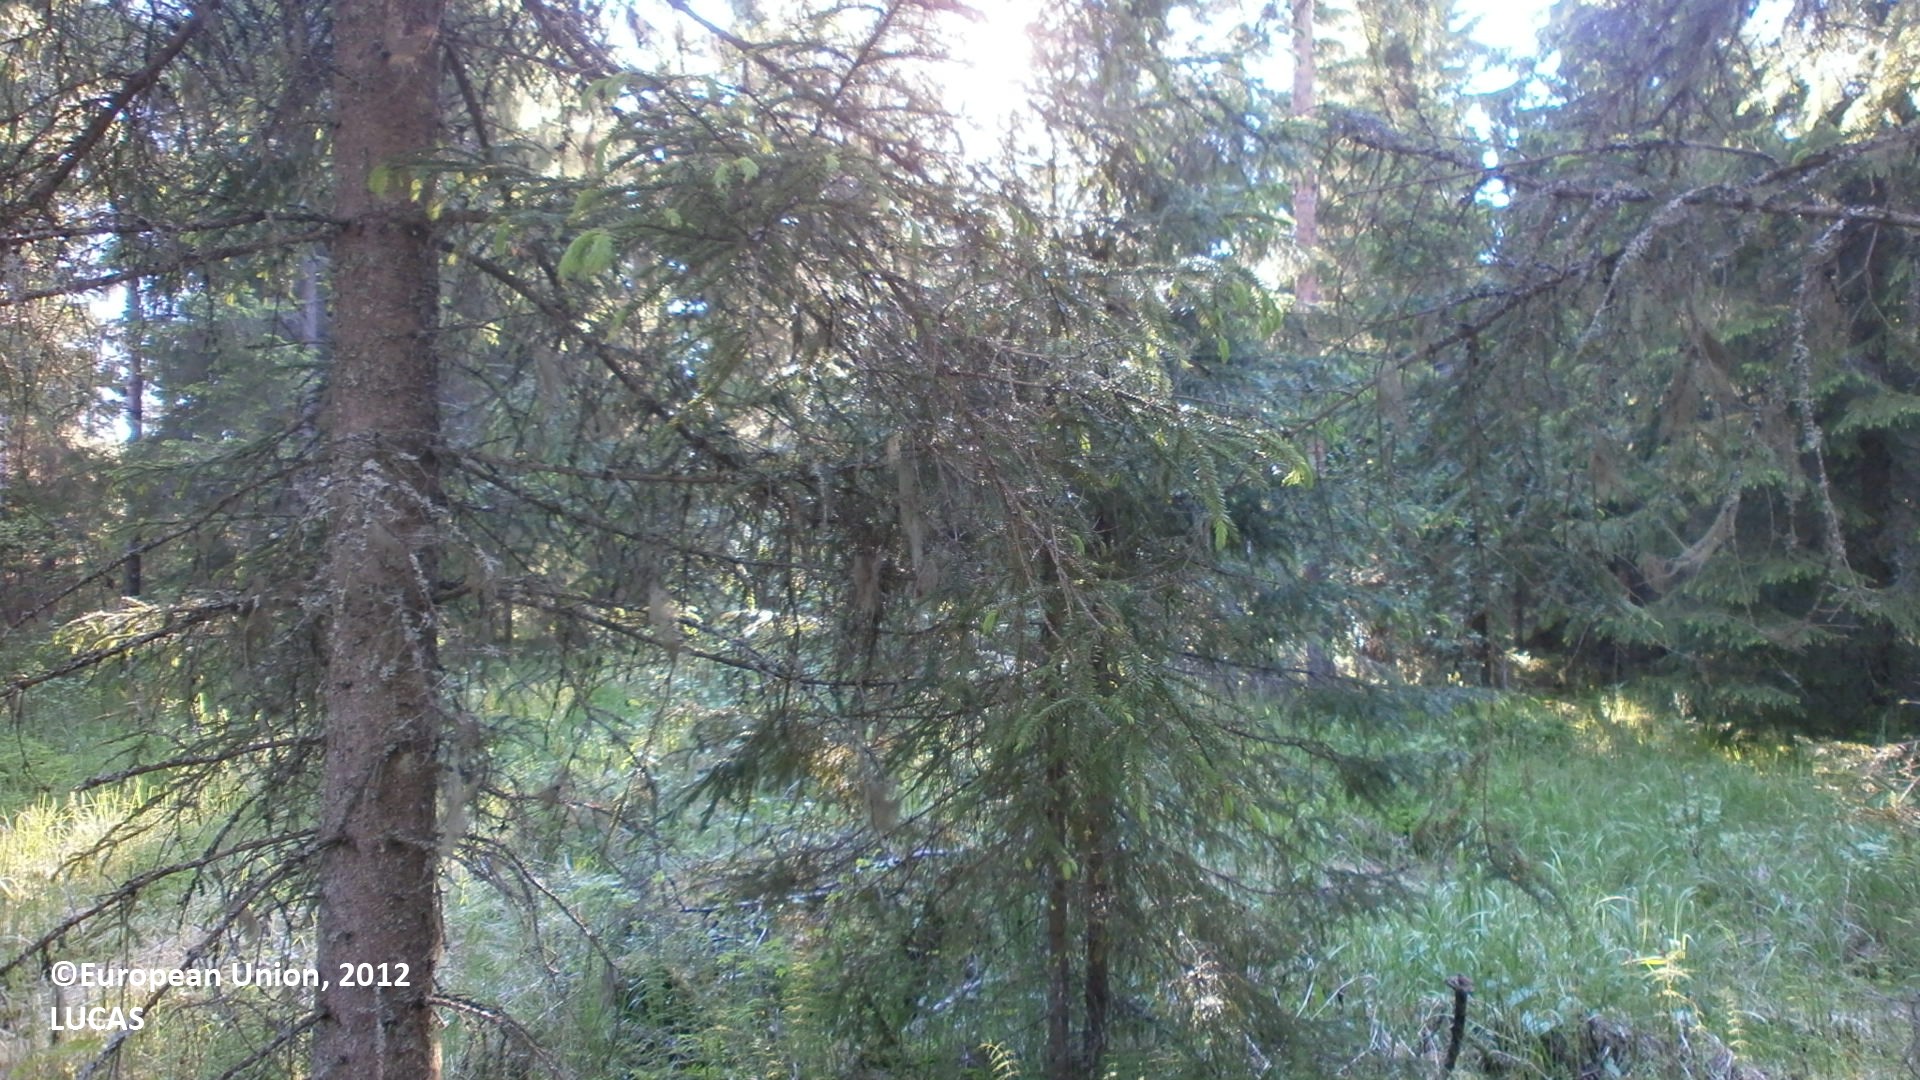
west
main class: Woodland
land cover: Spruce dominated coniferous woodland
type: mire and swamp forests
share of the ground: 50 - 75 %
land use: Forestry
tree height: > 5 m
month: June
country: FI
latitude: 64.0853
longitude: 25.7485
